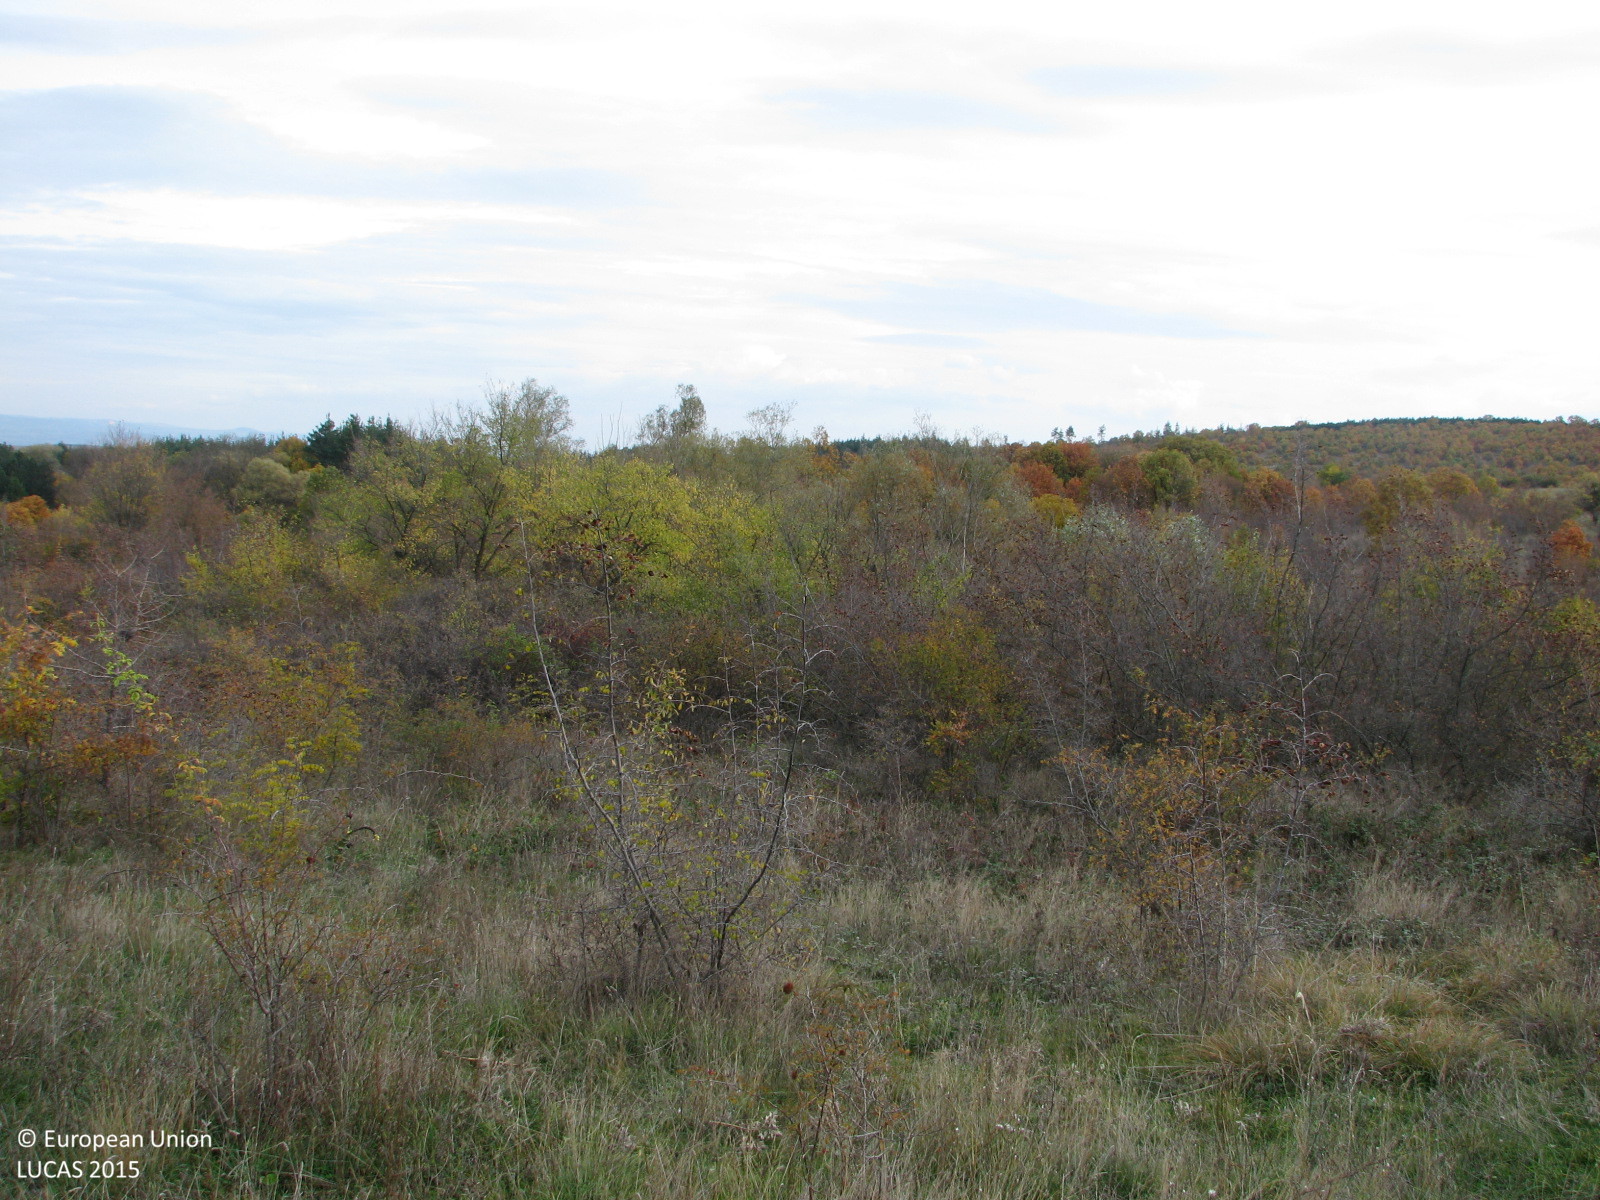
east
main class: Grassland
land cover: Grassland with sparse tree/shrub cover
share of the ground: > 75 %
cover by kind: herbaceous plants 85 %, shrubs 10 %, broadleaved forest trees 5 %
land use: Agriculture (excluding fallow land and kitchen gardens)
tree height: < 5 m
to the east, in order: Grassland with sparse tree/shrub cover; Shrubland without tree cover; Grassland with sparse tree/shrub cover; Shrubland without tree cover; Grass margins; Tracks; Grassland with sparse tree/shrub cover; Shrubland with sparse tree cover; Grassland without tree/shrub cover; Shrubland with sparse tree cover; Pine dominated mixed woodland
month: November
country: BG
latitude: 41.9710
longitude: 26.3856
